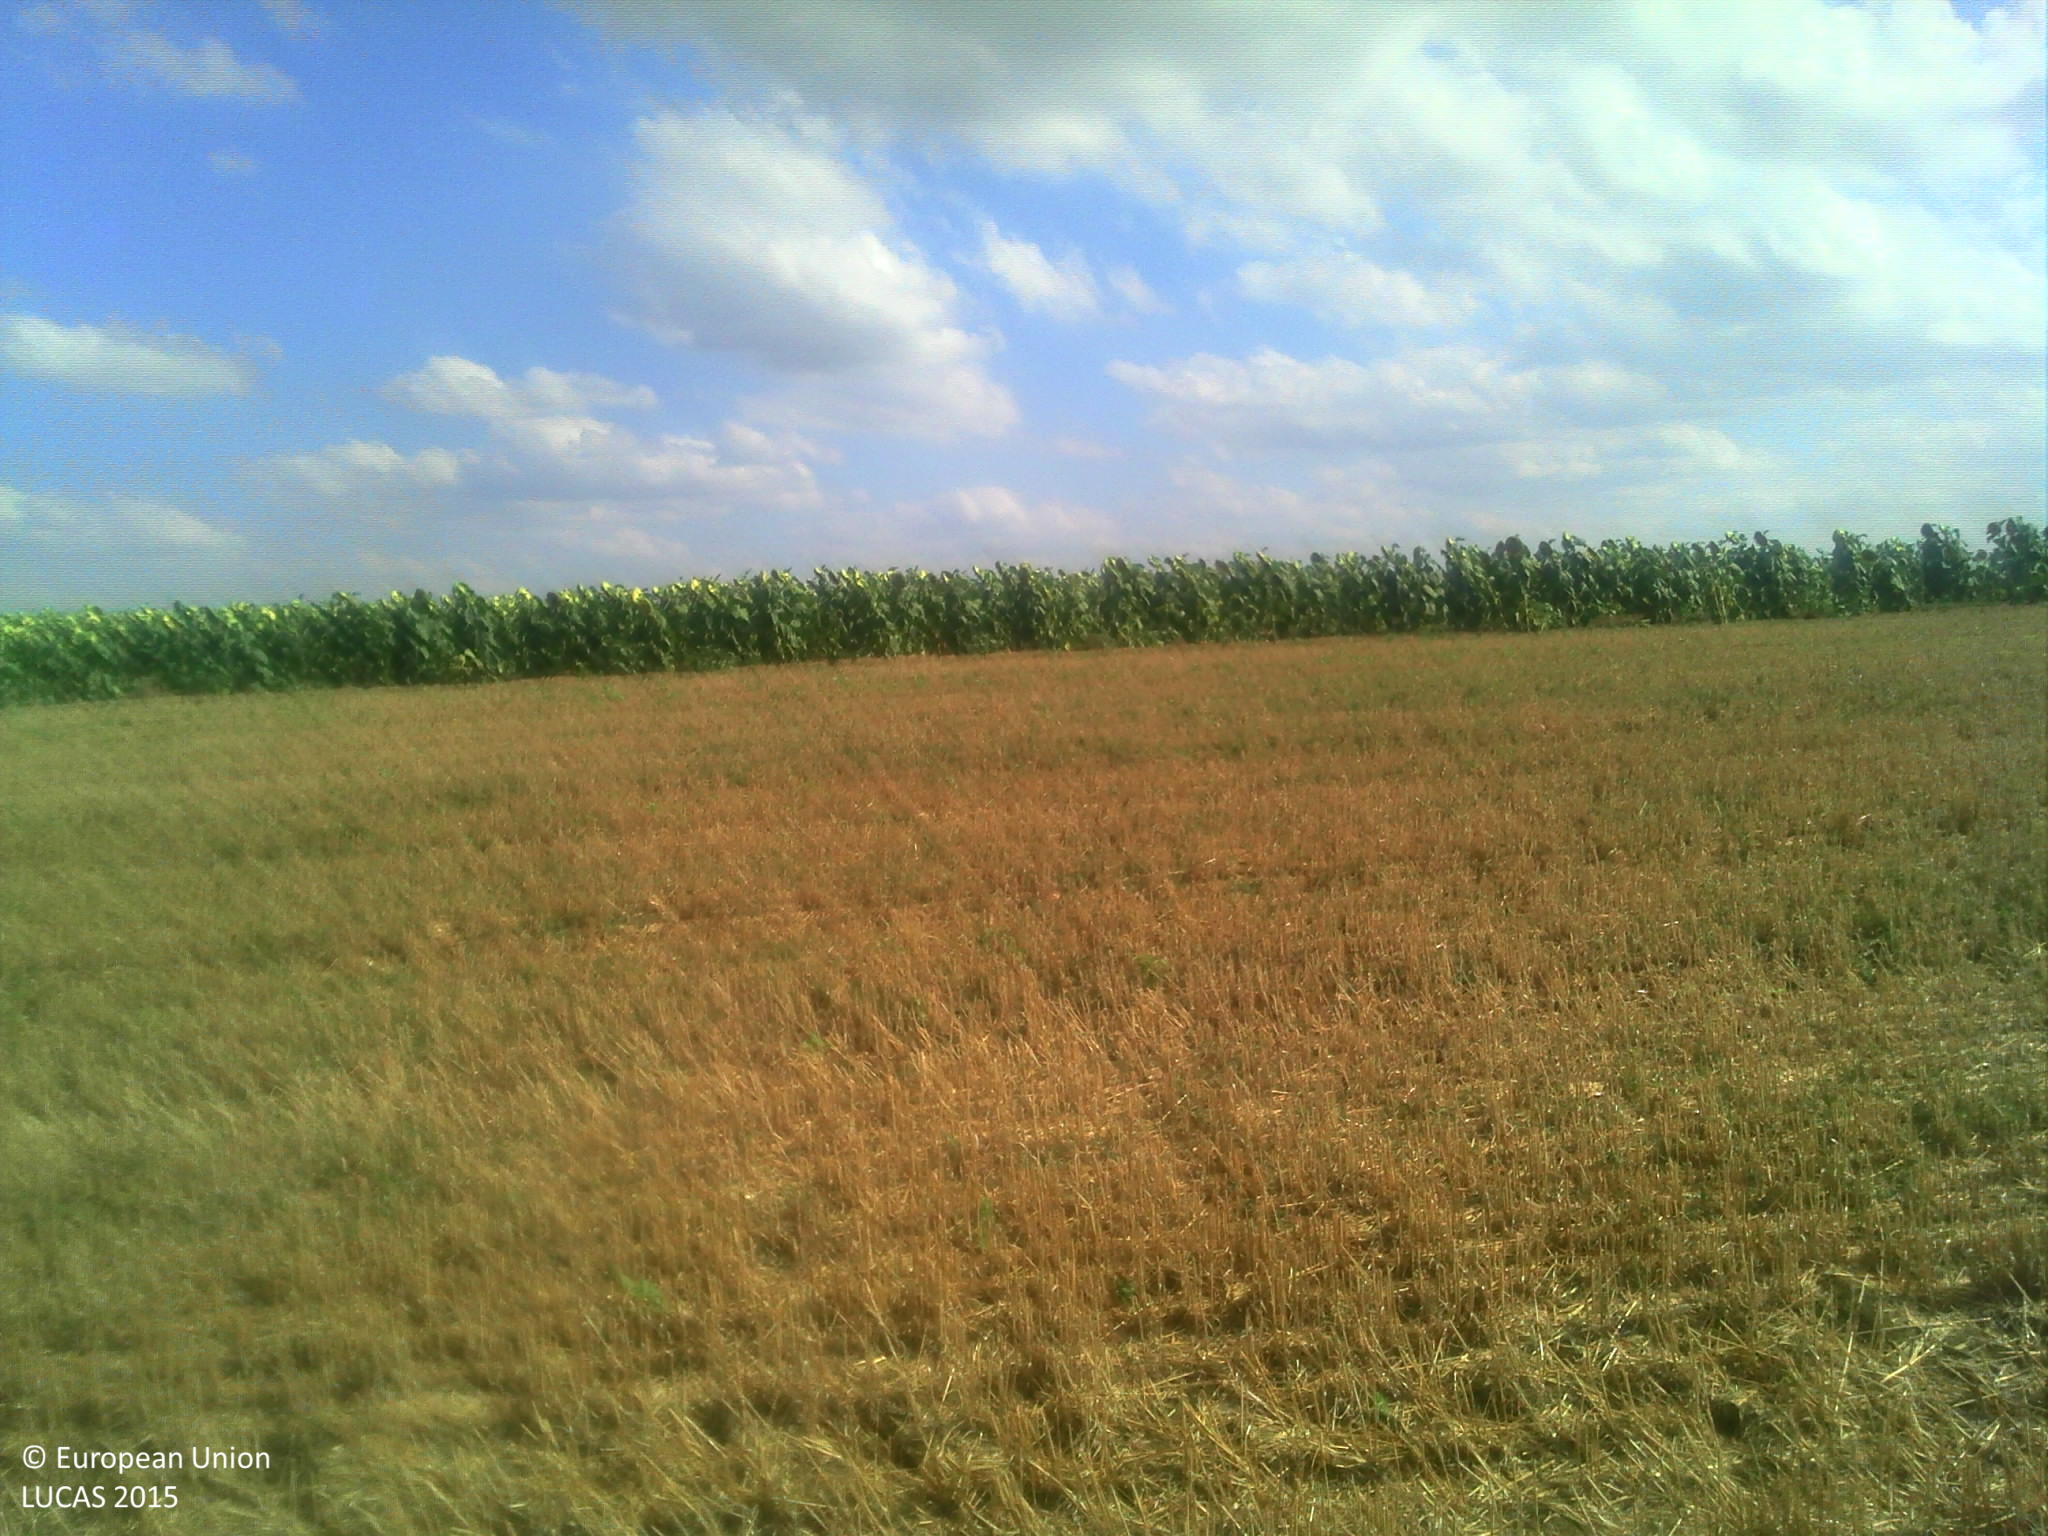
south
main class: Cropland
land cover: Common wheat
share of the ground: > 75 %
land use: Agriculture (excluding fallow land and kitchen gardens)
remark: Harvested field
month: July
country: FR
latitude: 44.0163
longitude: 0.6276
